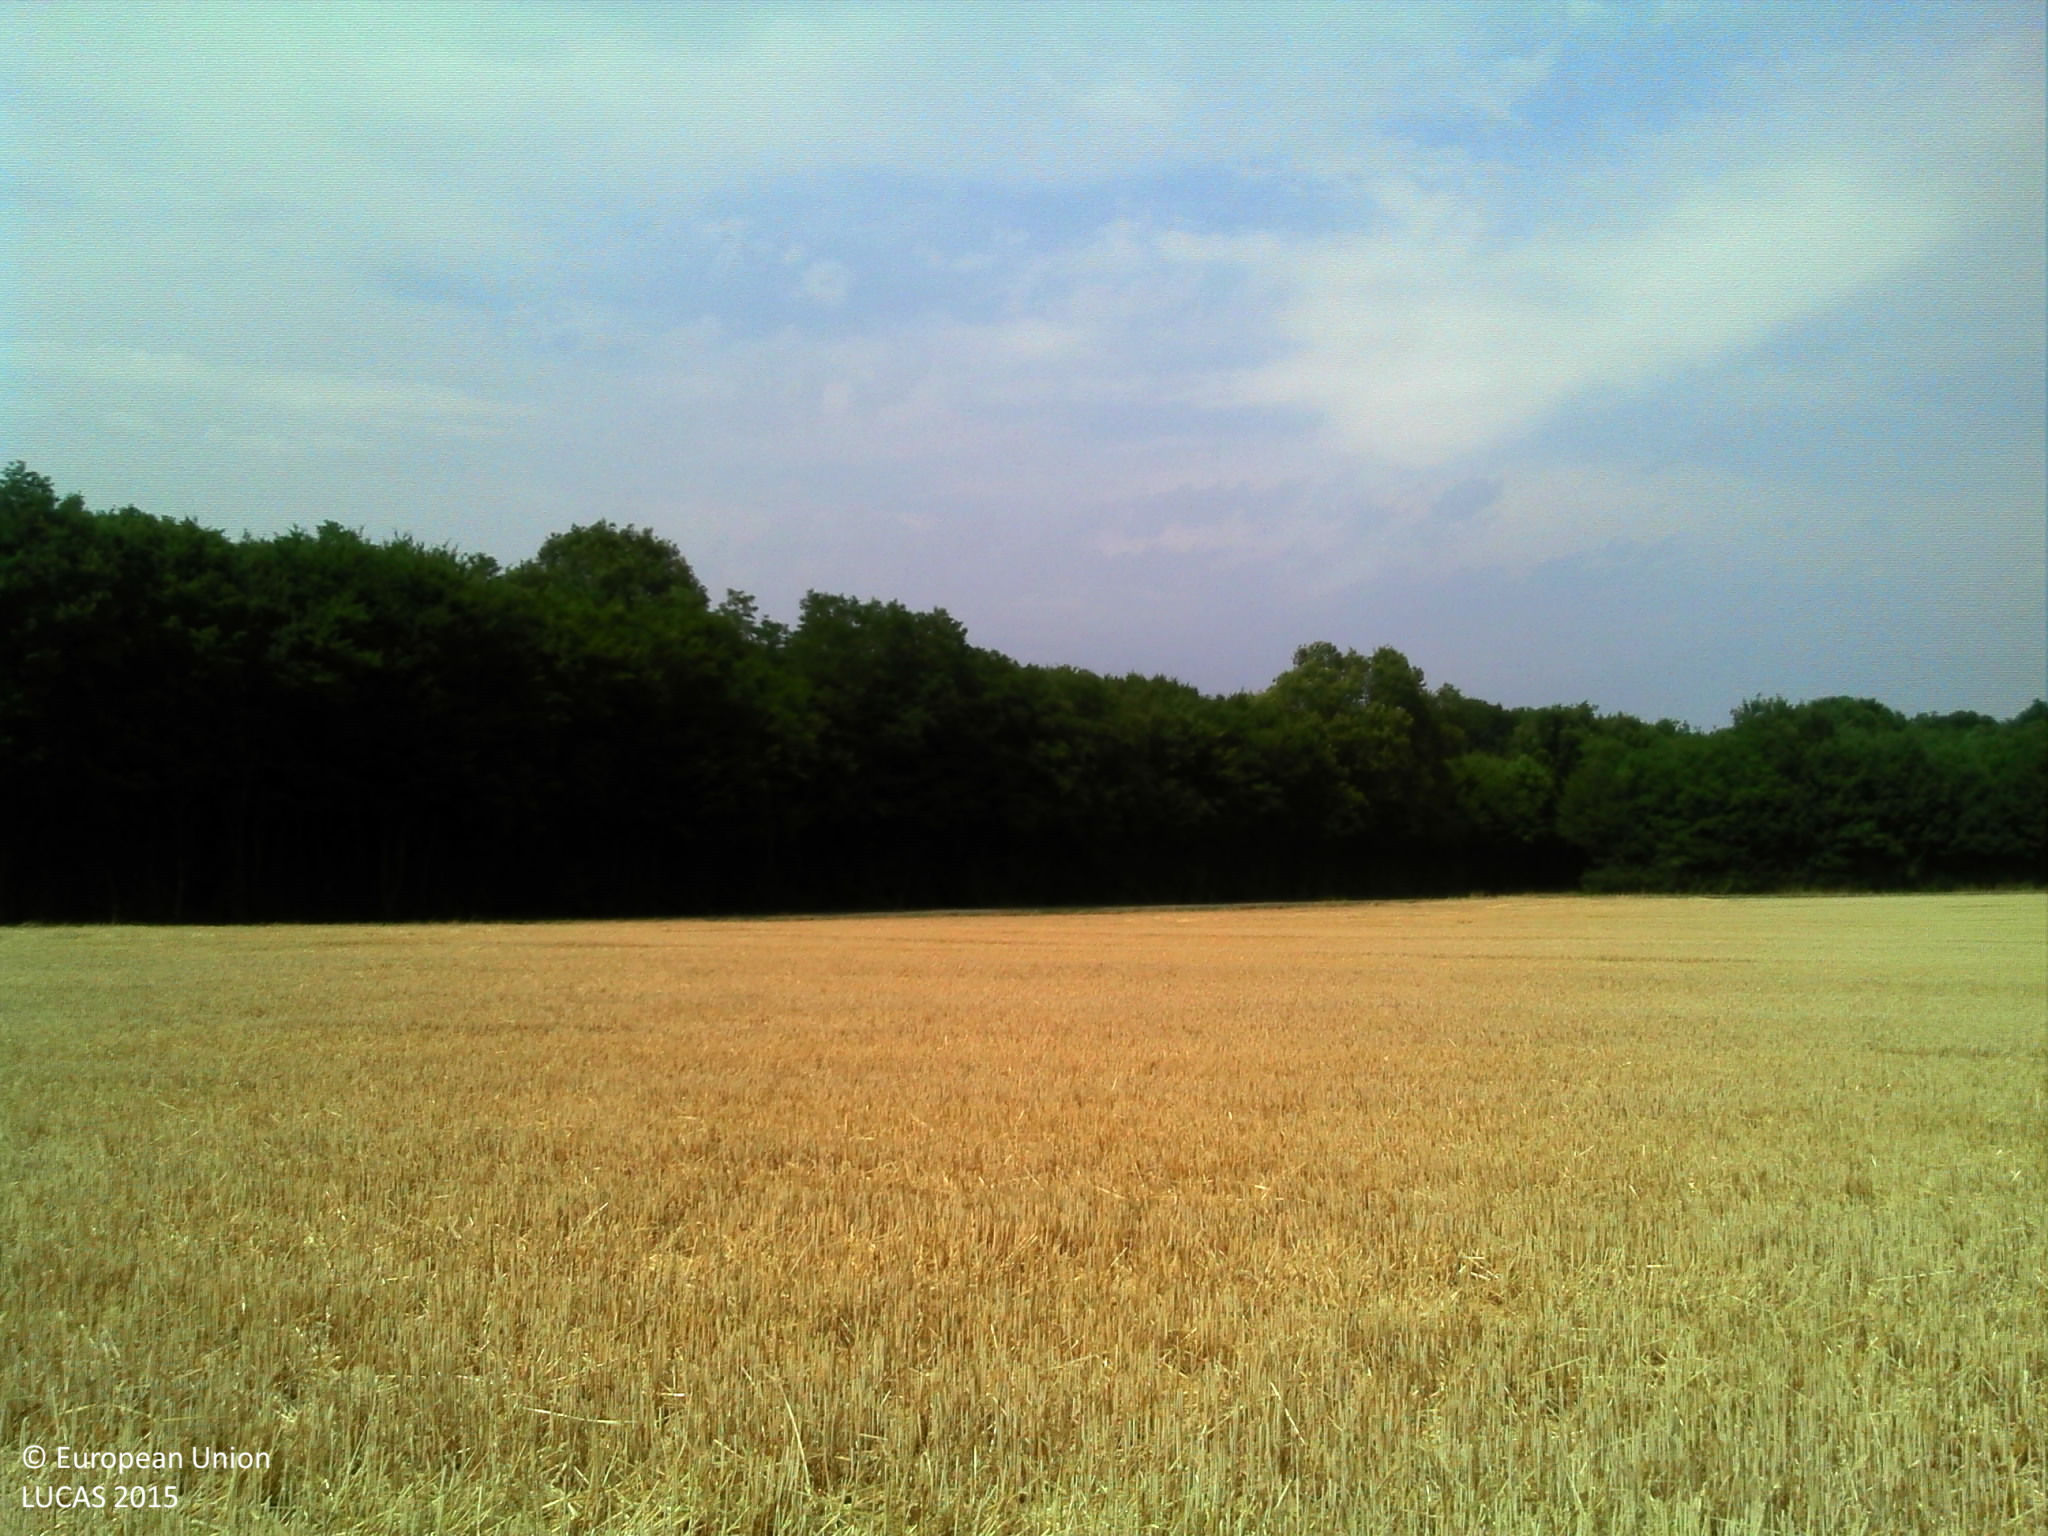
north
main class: Cropland
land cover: Barley
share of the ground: > 75 %
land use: Agriculture (excluding fallow land and kitchen gardens)
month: July
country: FR
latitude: 47.9716
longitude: 2.8257
